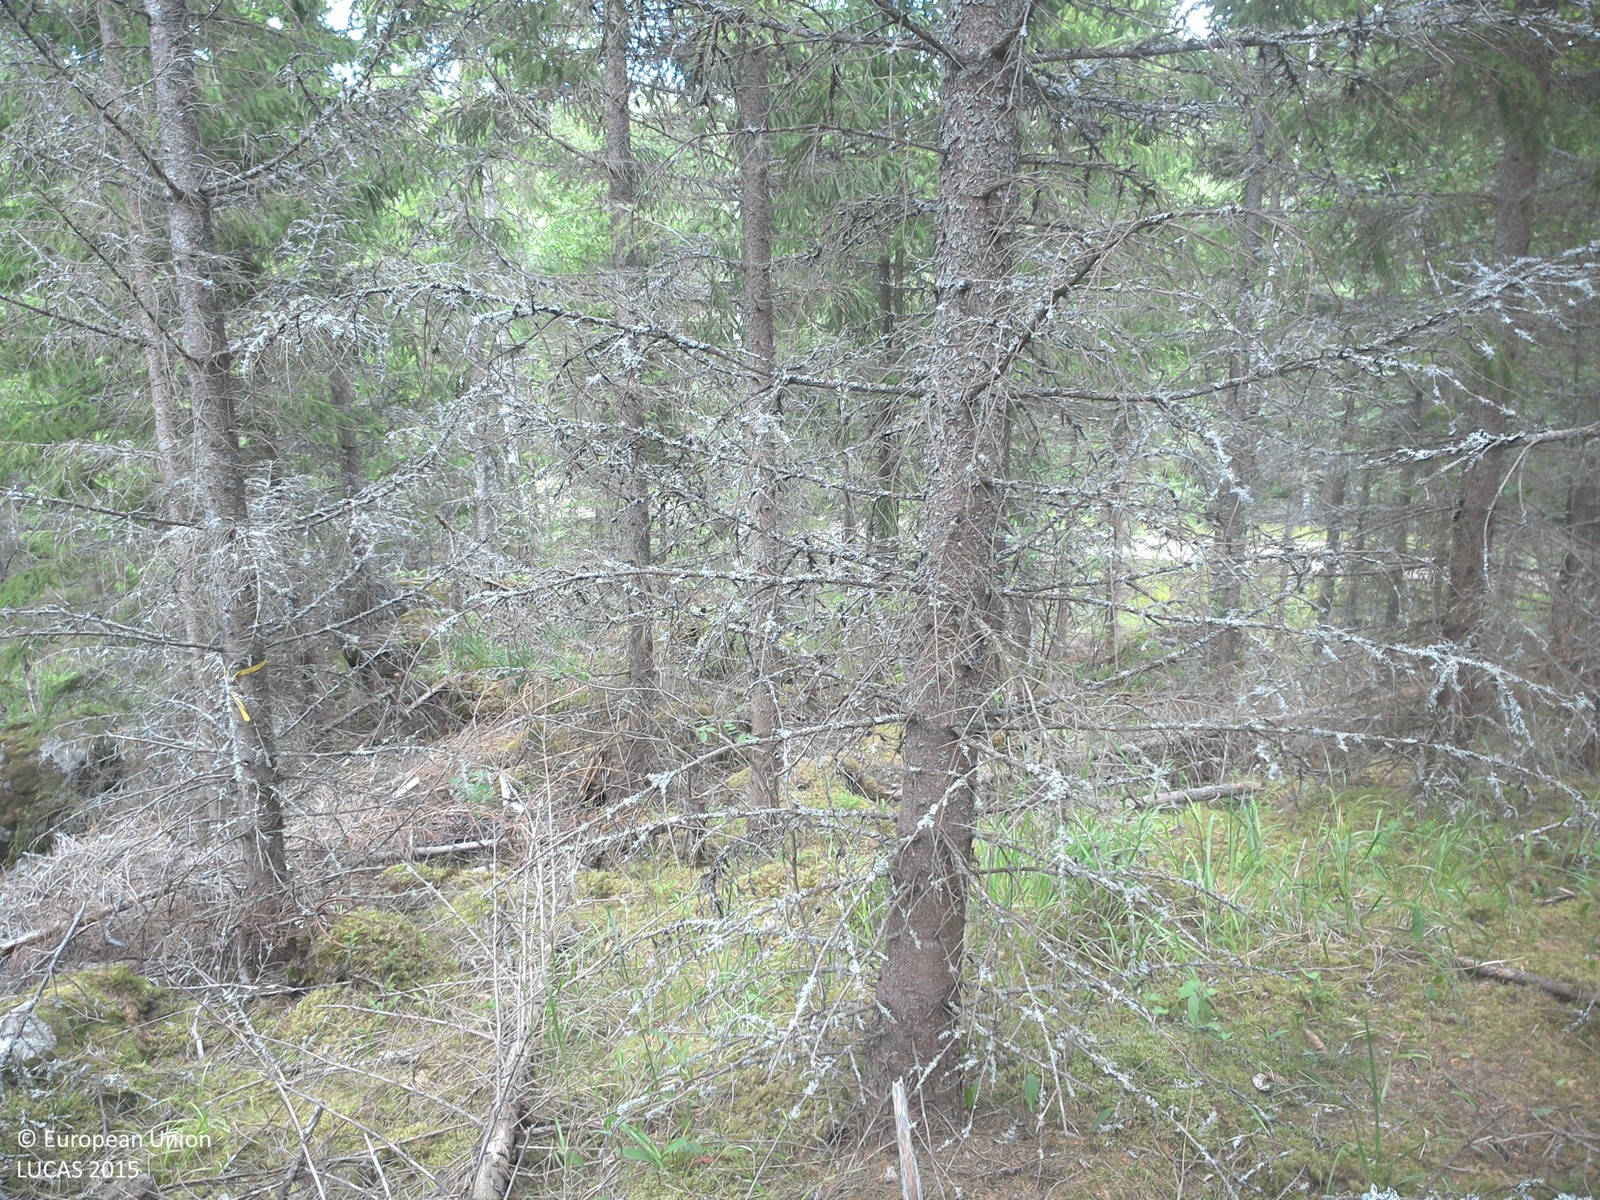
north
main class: Woodland
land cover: Spruce dominated coniferous woodland
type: boreal forest
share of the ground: 50 - 75 %
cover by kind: coniferous forest trees 60 %, lichens and mosses 40 %
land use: Forestry
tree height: > 5 m
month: June
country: SE
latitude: 58.0132
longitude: 16.0050
